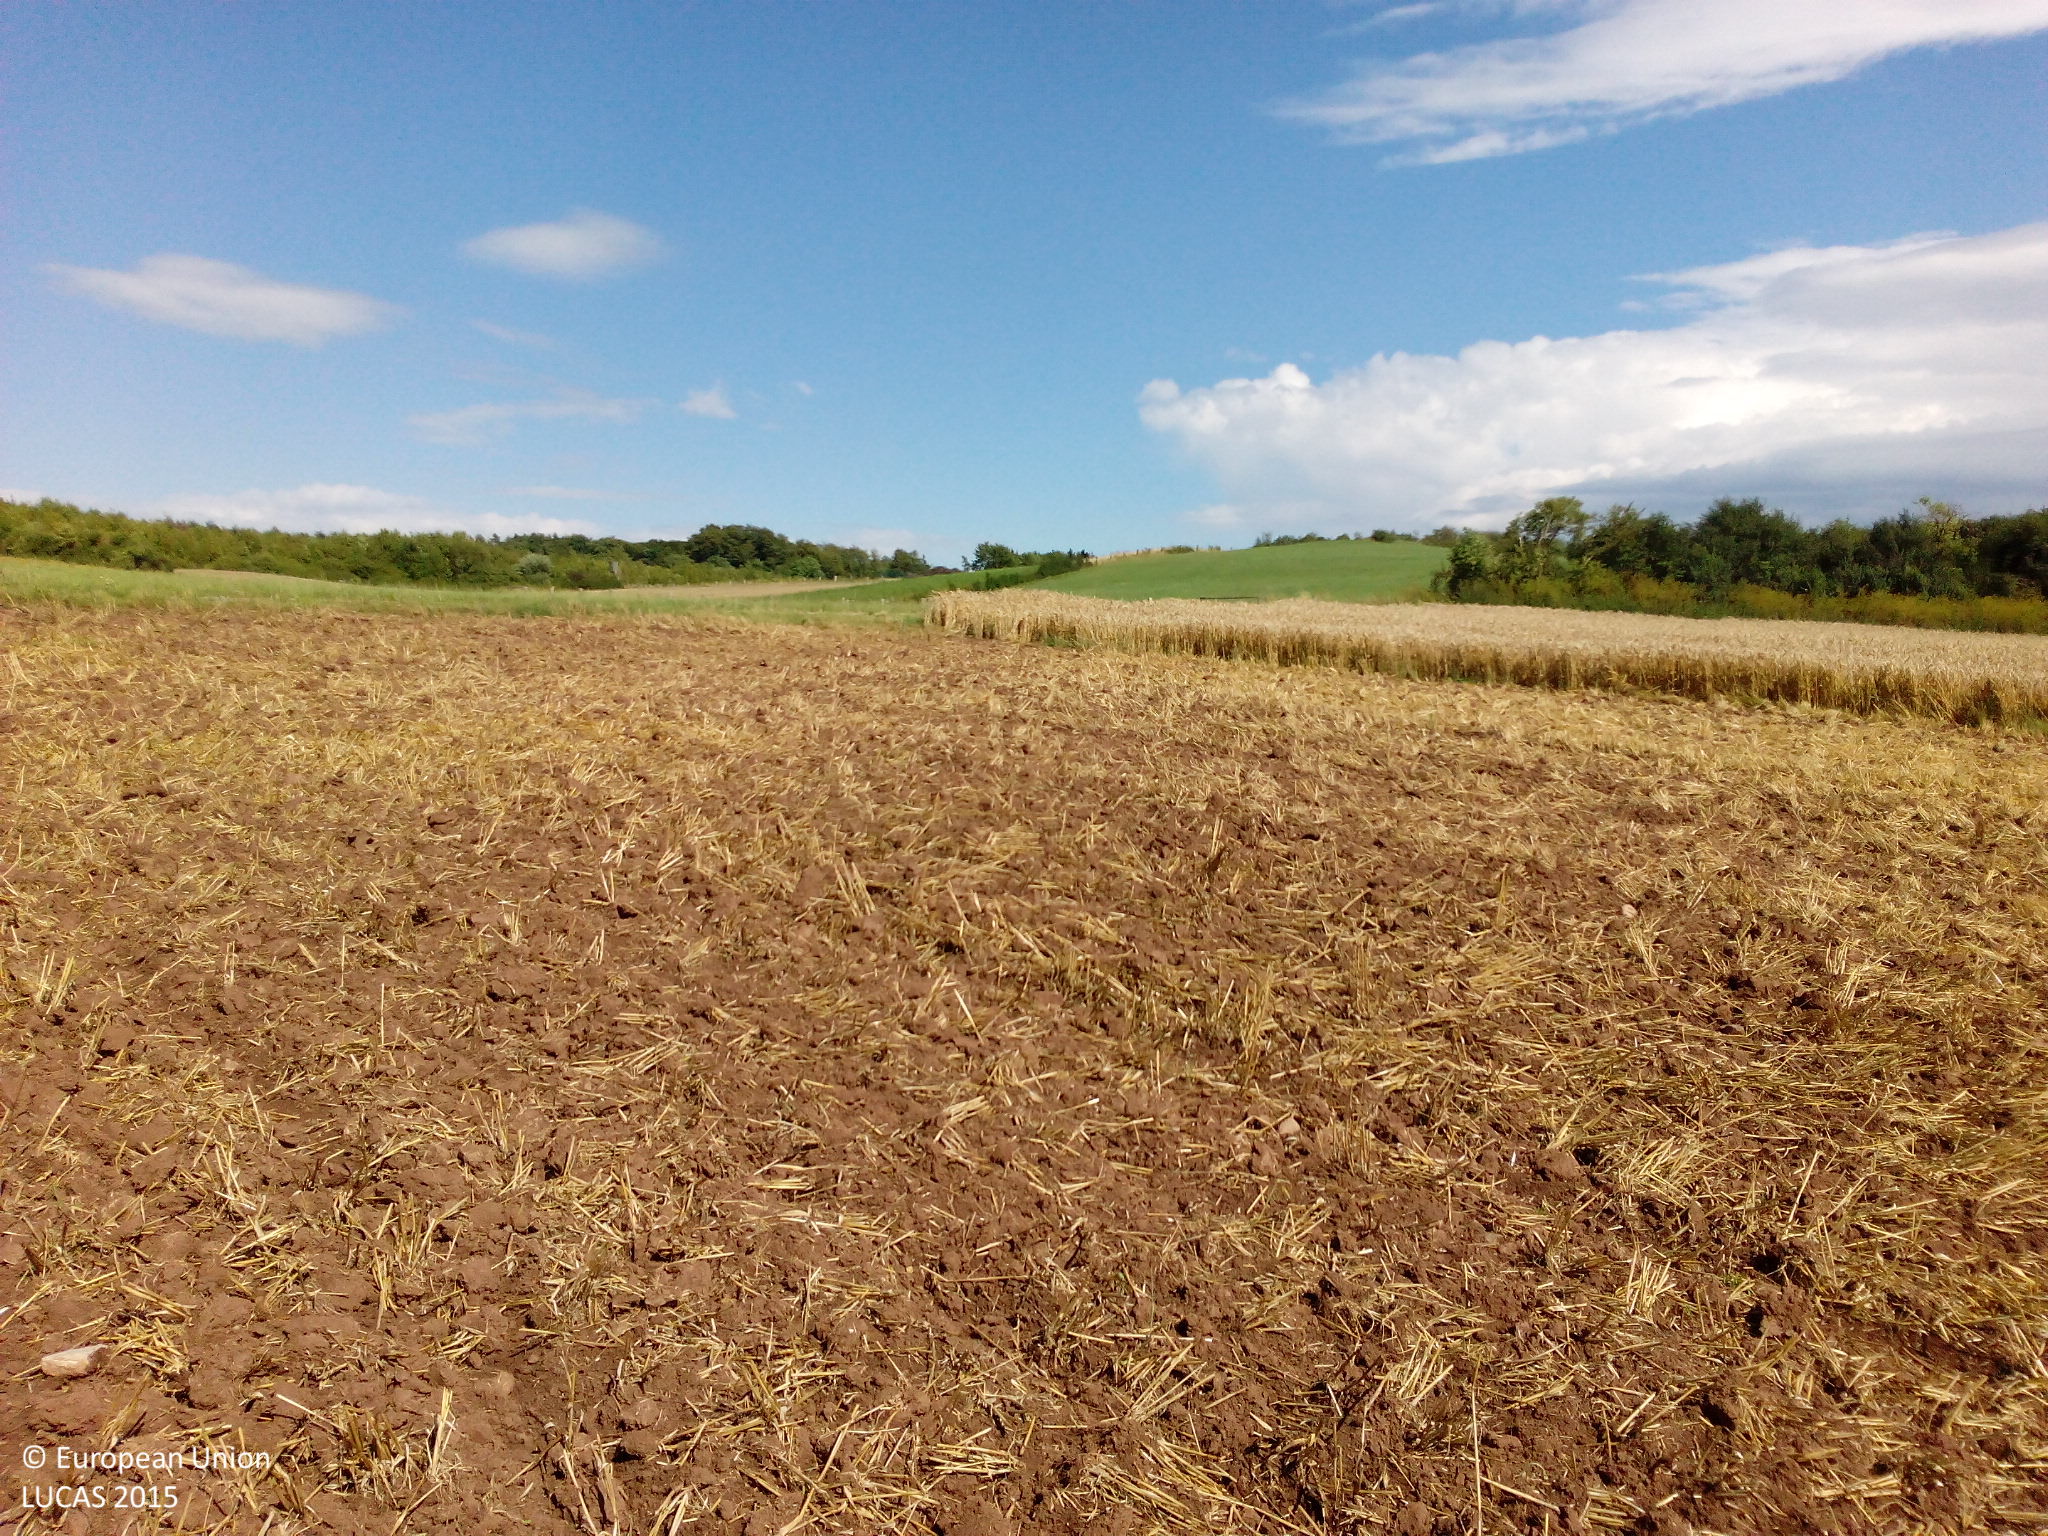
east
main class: Cropland
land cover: Barley
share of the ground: < 10 %
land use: Agriculture (excluding fallow land and kitchen gardens)
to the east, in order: Barley; Common wheat; Shruby margins; Tracks; Grassland without tree/shrub cover; Tracks; Grass margins; Fences; Grassland without tree/shrub cover; Fences; Shruby margins; Spontaneously vegetated surfaces
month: July
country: DE
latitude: 51.4230
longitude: 9.3530
